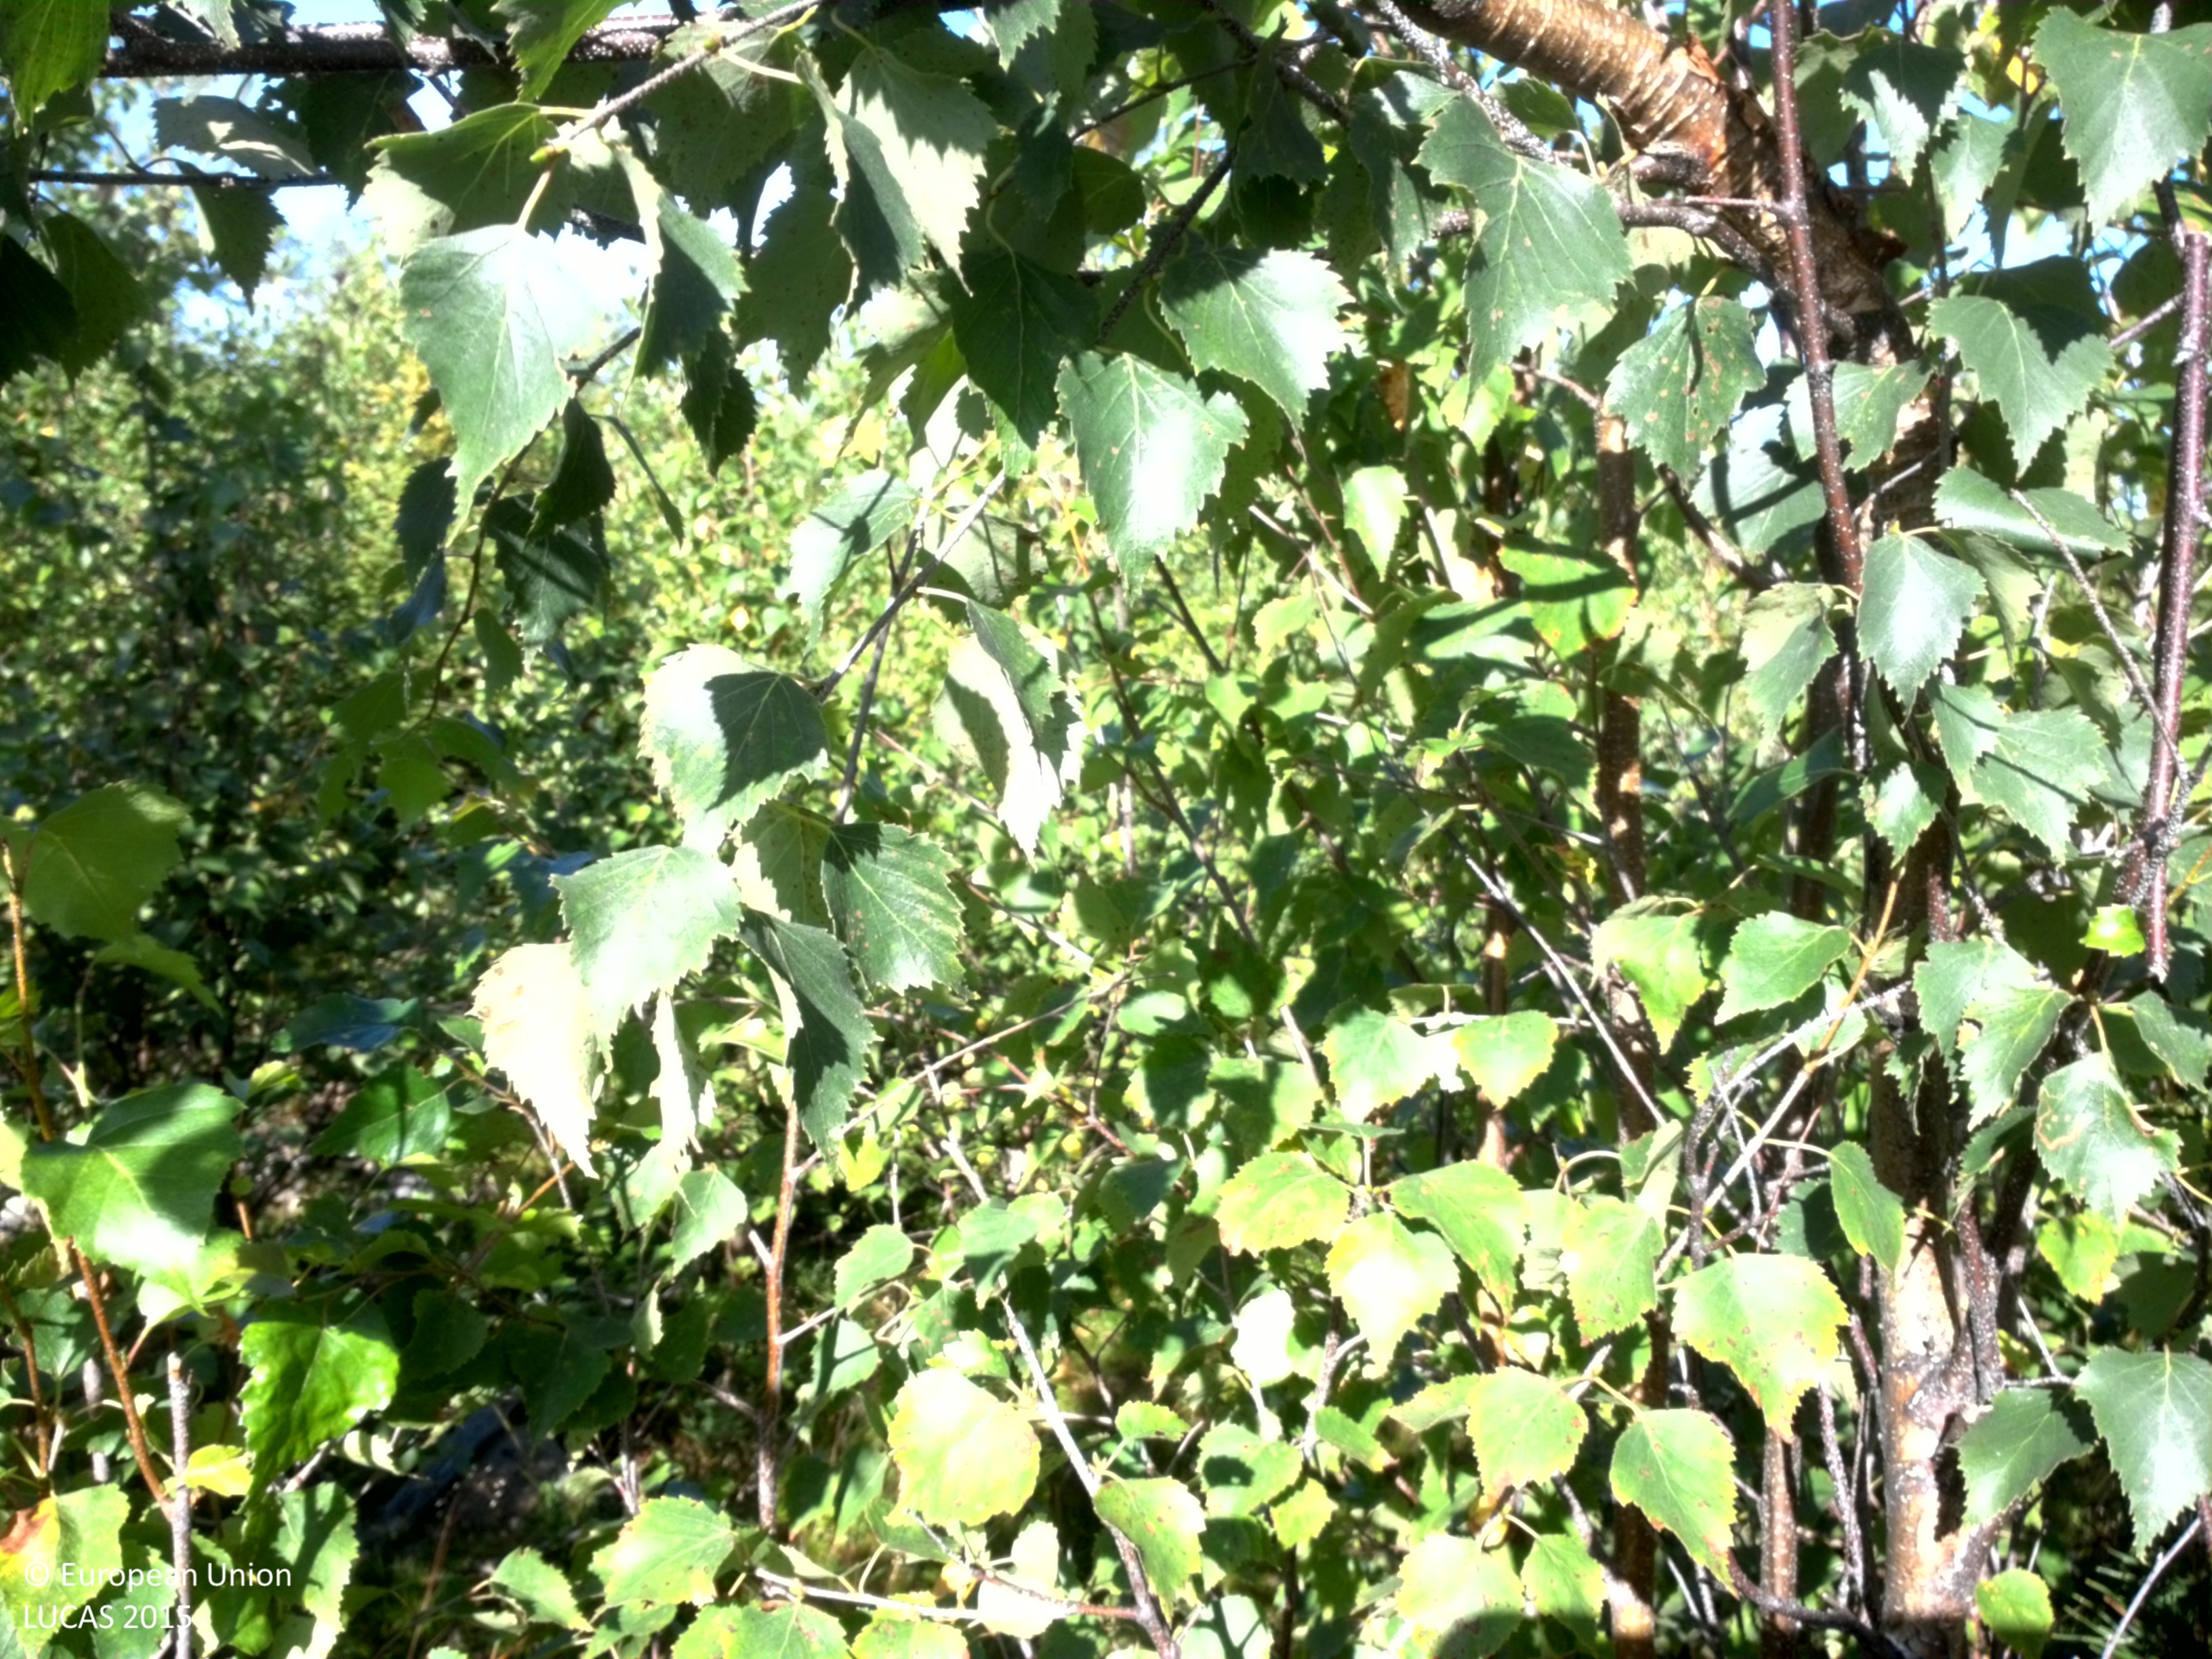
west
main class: Woodland
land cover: Broadleaved woodland
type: boreal forest
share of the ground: > 75 %
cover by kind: broadleaved forest trees 75 %, coniferous forest trees 10 %, shrubs 10 %, herbaceous plants 5 %
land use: Forestry
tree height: < 5 m
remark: Clear cut
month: August
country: SE
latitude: 64.5005
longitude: 20.5745
